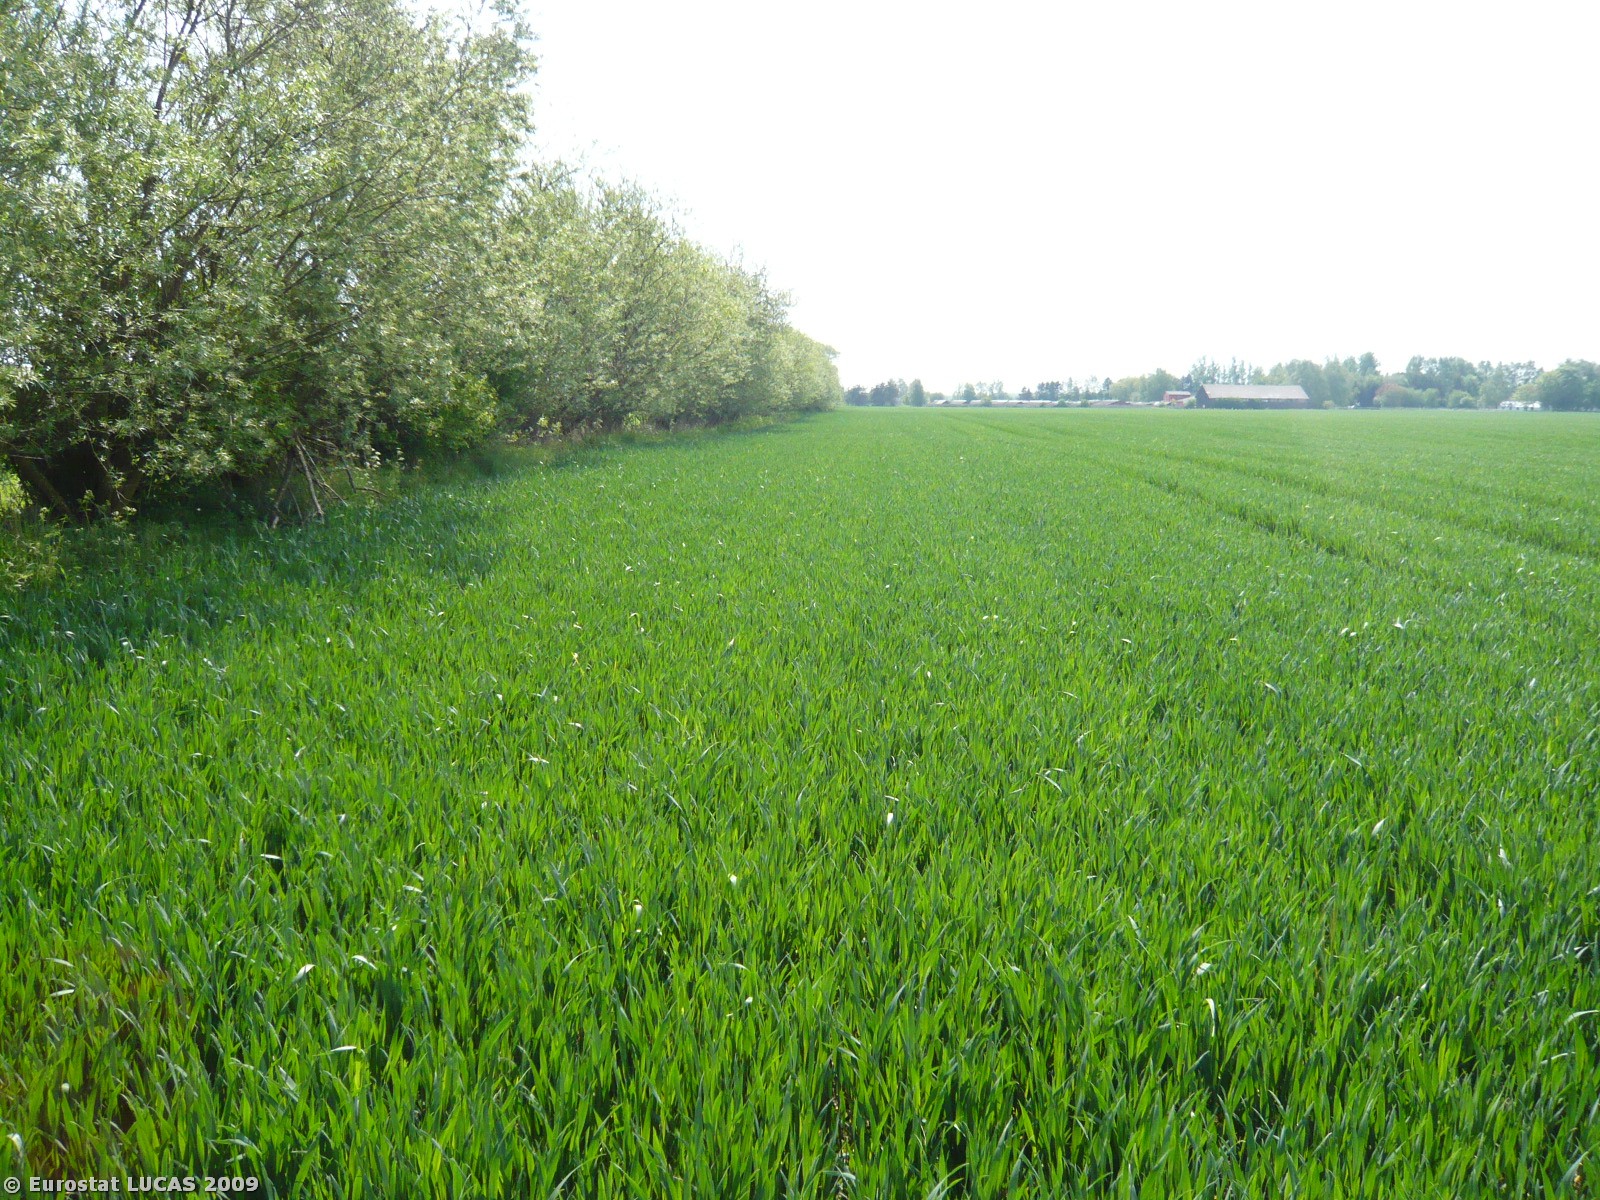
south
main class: Cropland
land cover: Common wheat
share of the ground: > 75 %
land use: Agriculture (excluding fallow land and kitchen gardens)
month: May
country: DK
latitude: 55.3419
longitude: 12.1901
